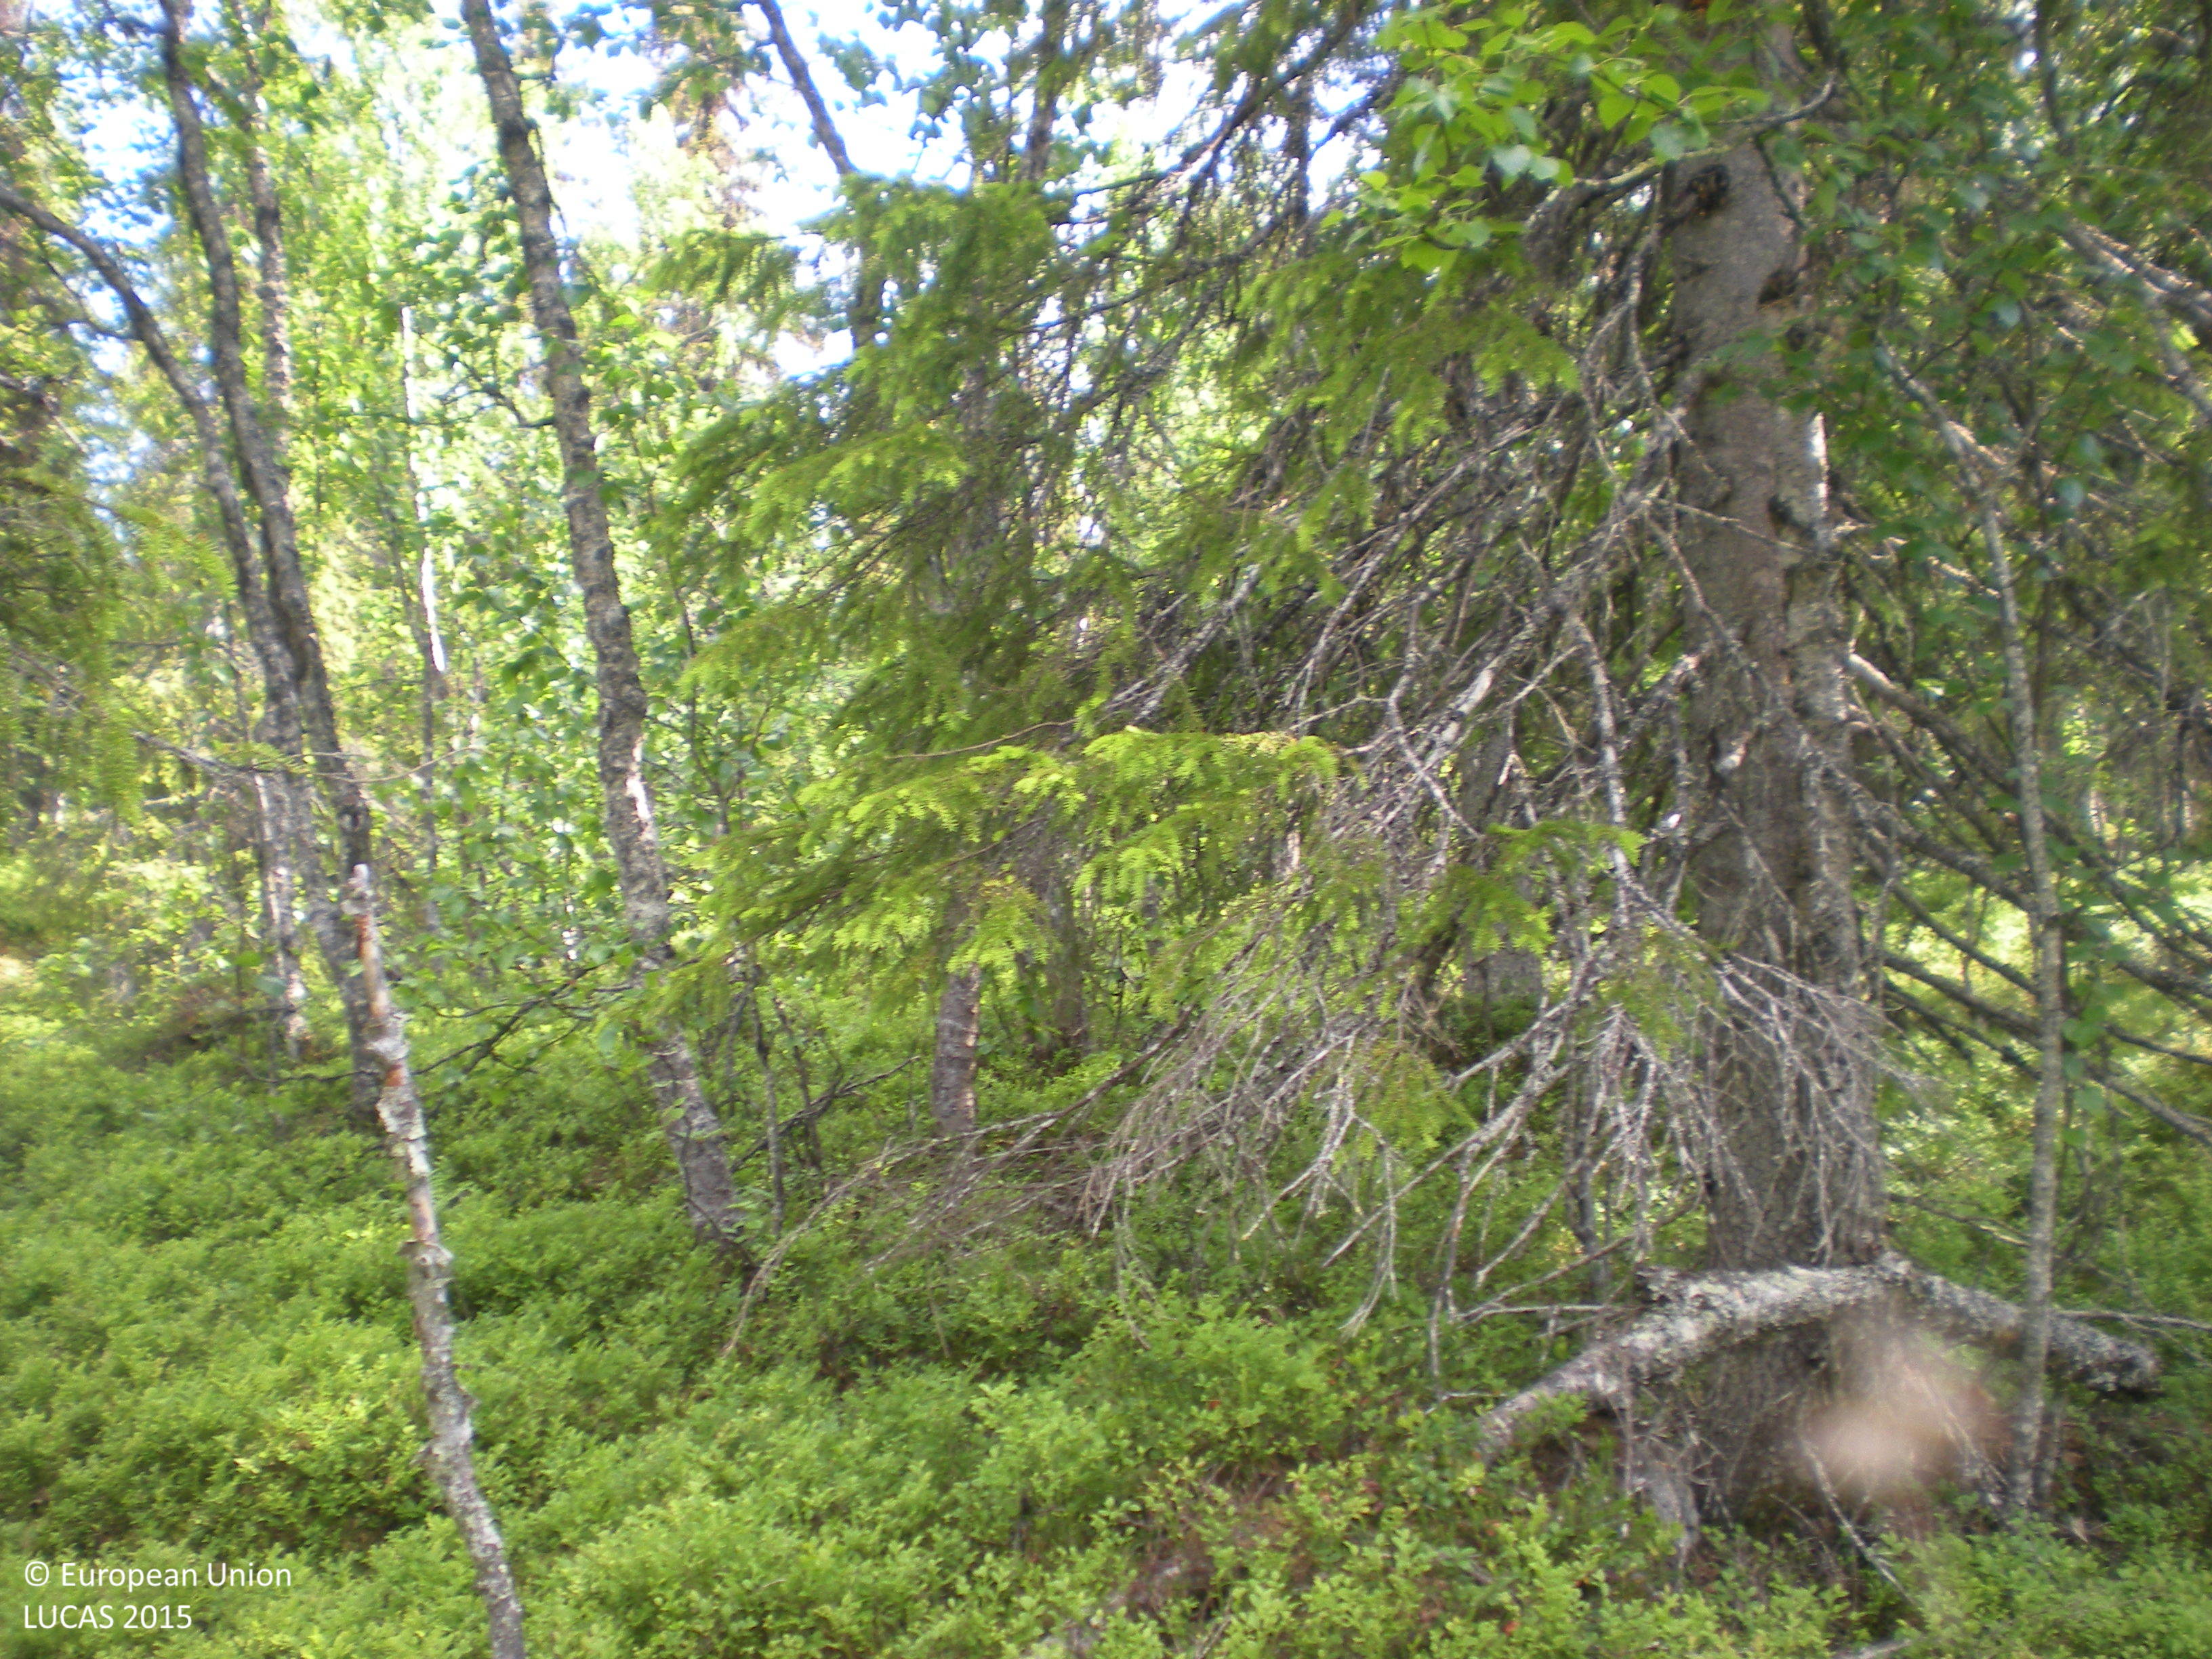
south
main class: Woodland
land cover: Spruce dominated mixed woodland
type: boreal forest
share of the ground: 50 - 75 %
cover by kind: coniferous forest trees 35 %, broadleaved forest trees 30 %, shrubs 25 %, lichens and mosses 10 %
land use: Forestry
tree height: > 5 m
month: July
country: SE
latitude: 65.5558
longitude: 16.8690
